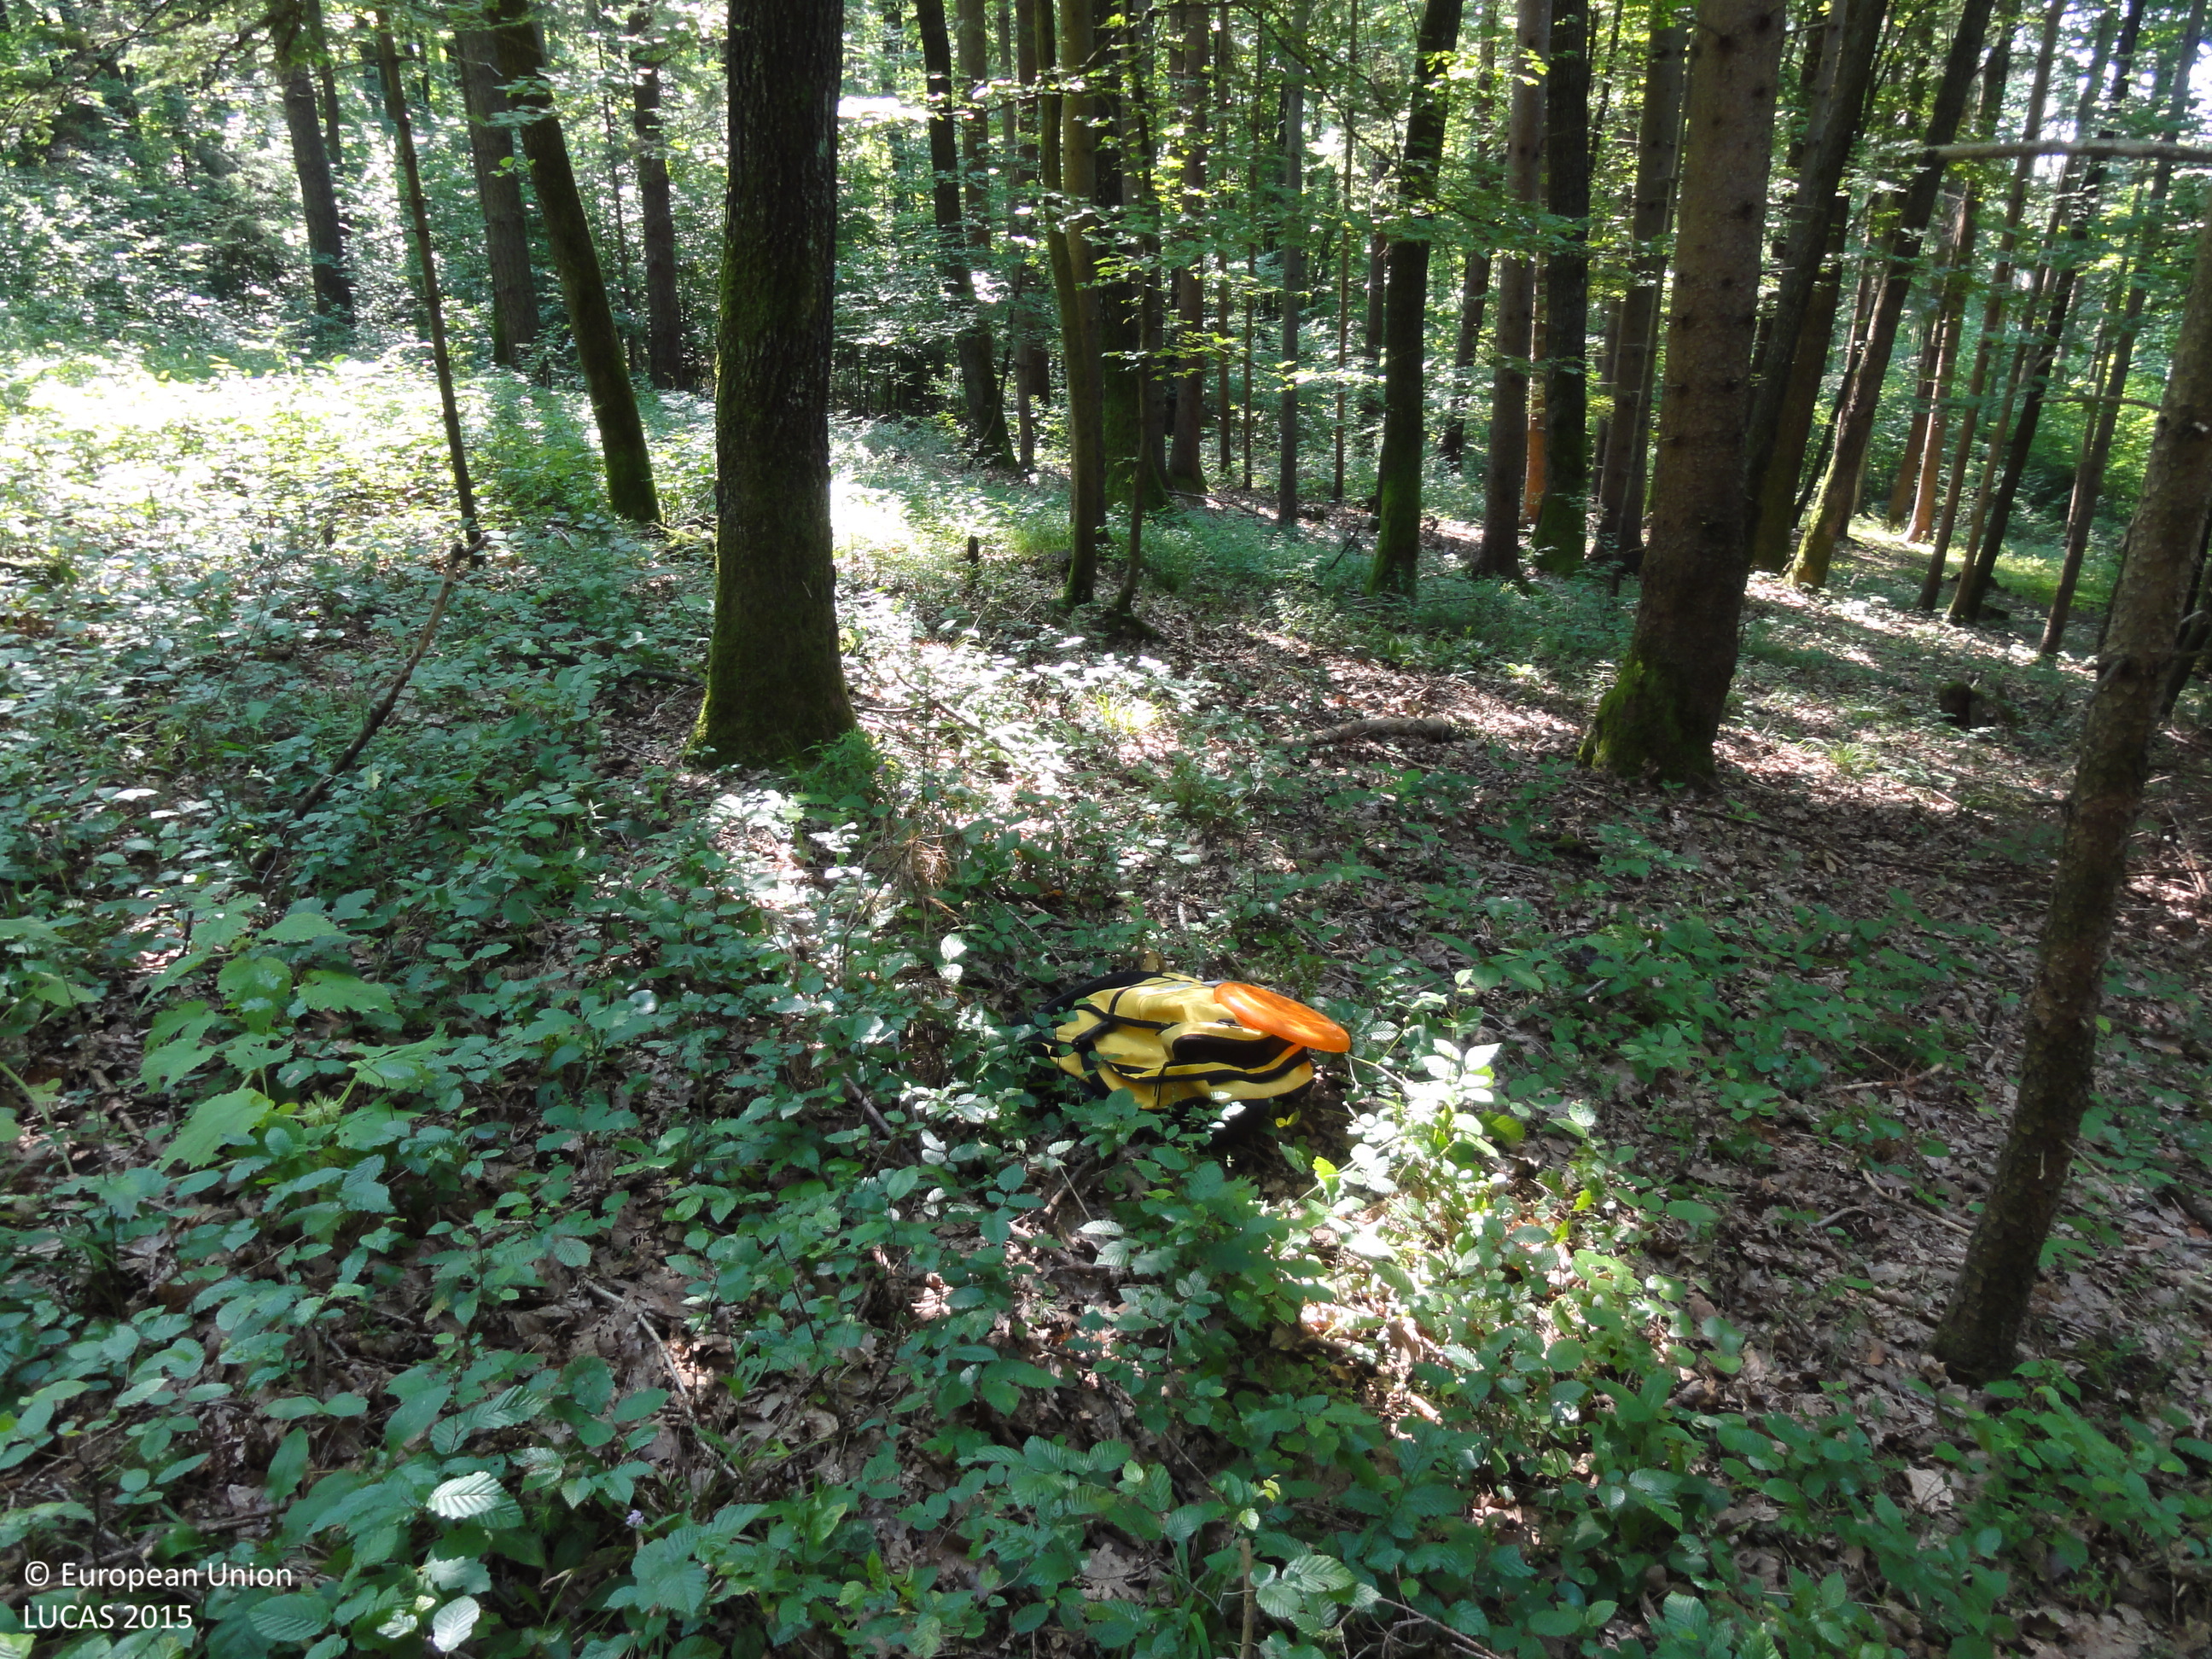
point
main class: Woodland
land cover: Spruce dominated mixed woodland
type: hemiboreal forest and nemoral coniferous forest and mixed broadleaved-coniferous forest
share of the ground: > 75 %
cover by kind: coniferous forest trees 60 %, broadleaved forest trees 40 %
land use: Forestry
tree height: > 5 m
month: July
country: SI
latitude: 46.3889
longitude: 15.5251
